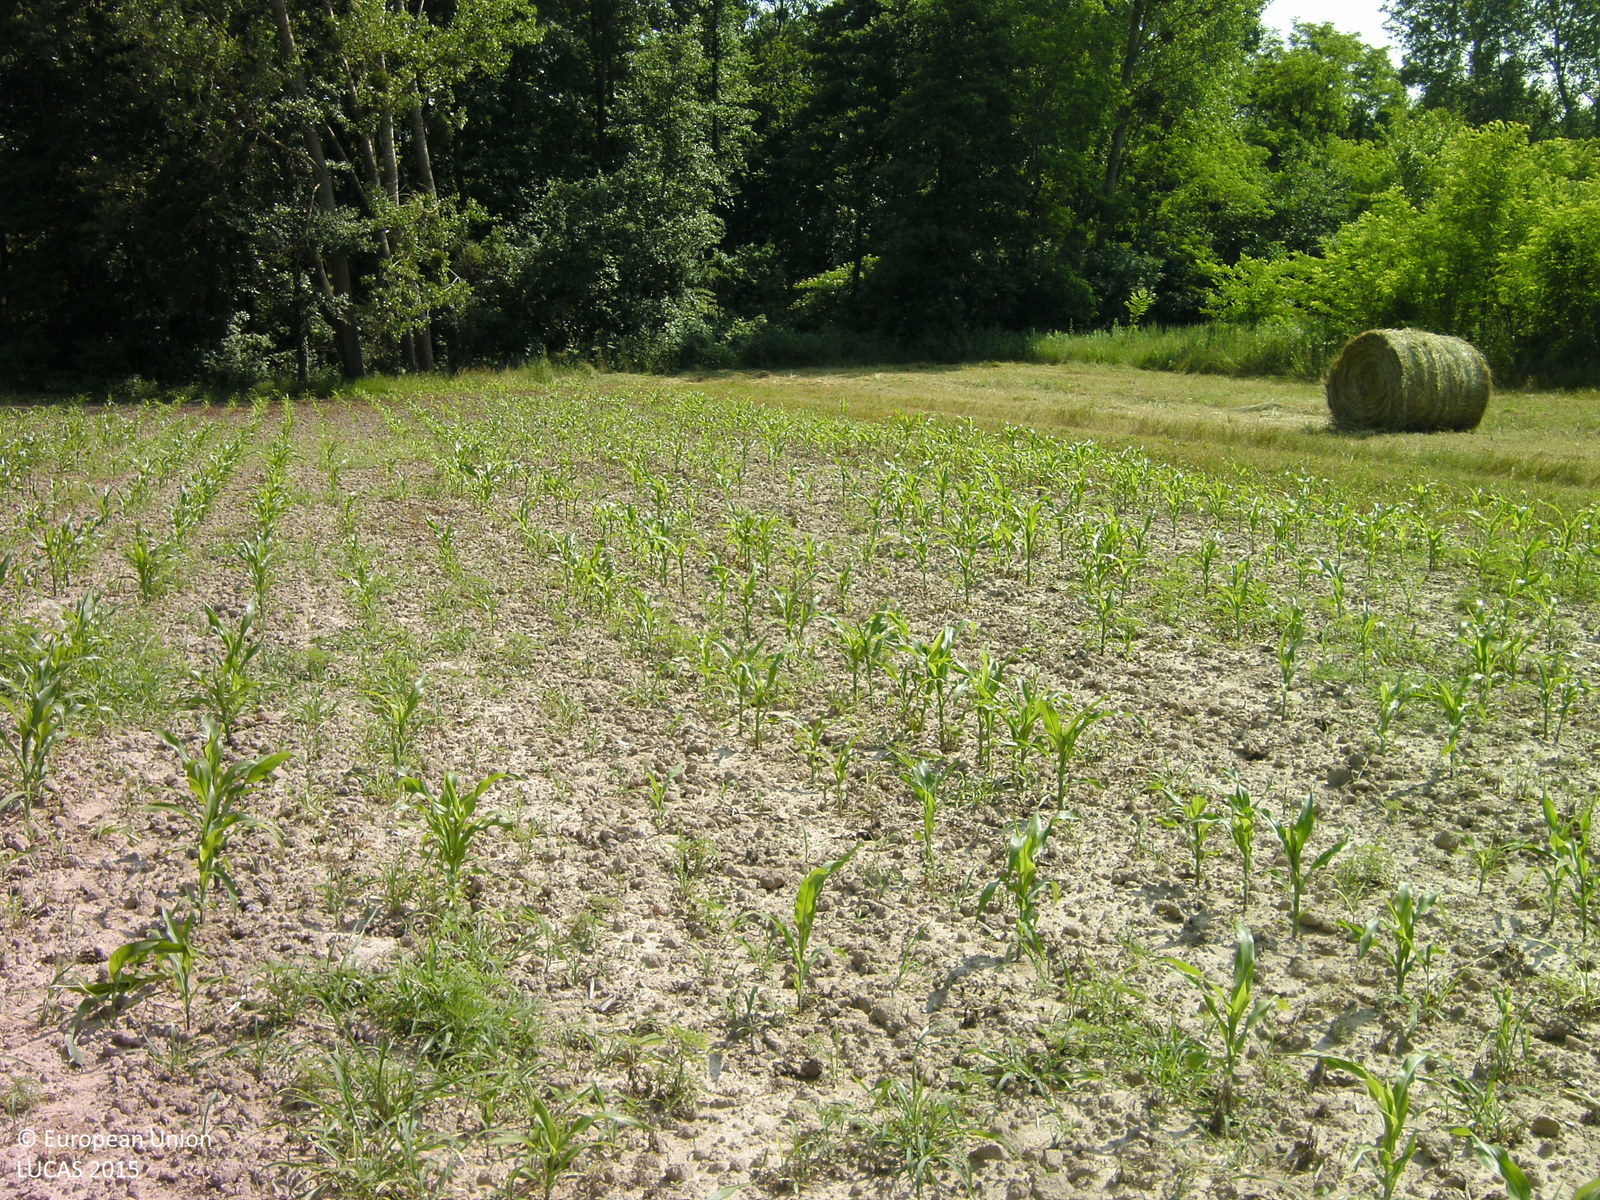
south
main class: Cropland
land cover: Maize
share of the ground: 10 - 25 %
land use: Agriculture (excluding fallow land and kitchen gardens)
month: June
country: HU
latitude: 46.4249
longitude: 17.5913
